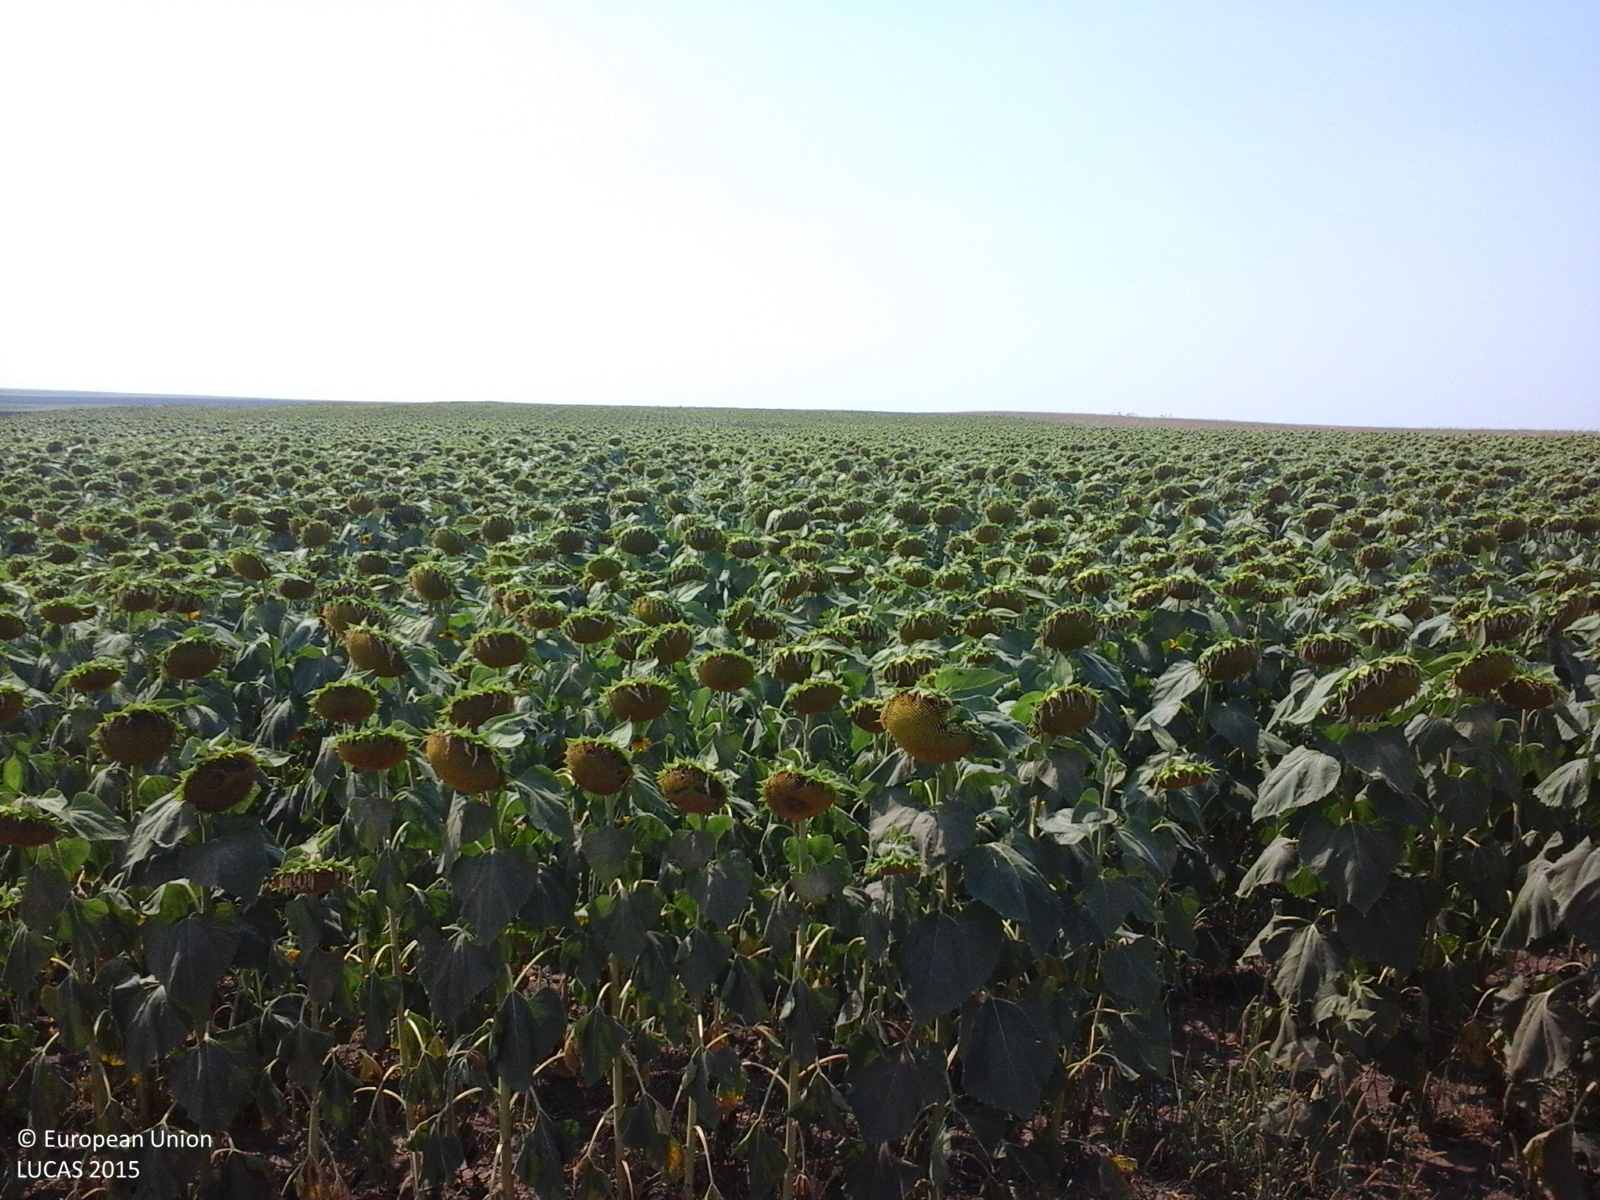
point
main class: Cropland
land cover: Sunflower
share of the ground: > 75 %
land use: Agriculture (excluding fallow land and kitchen gardens)
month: July
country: RO
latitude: 45.9122
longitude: 27.5770
